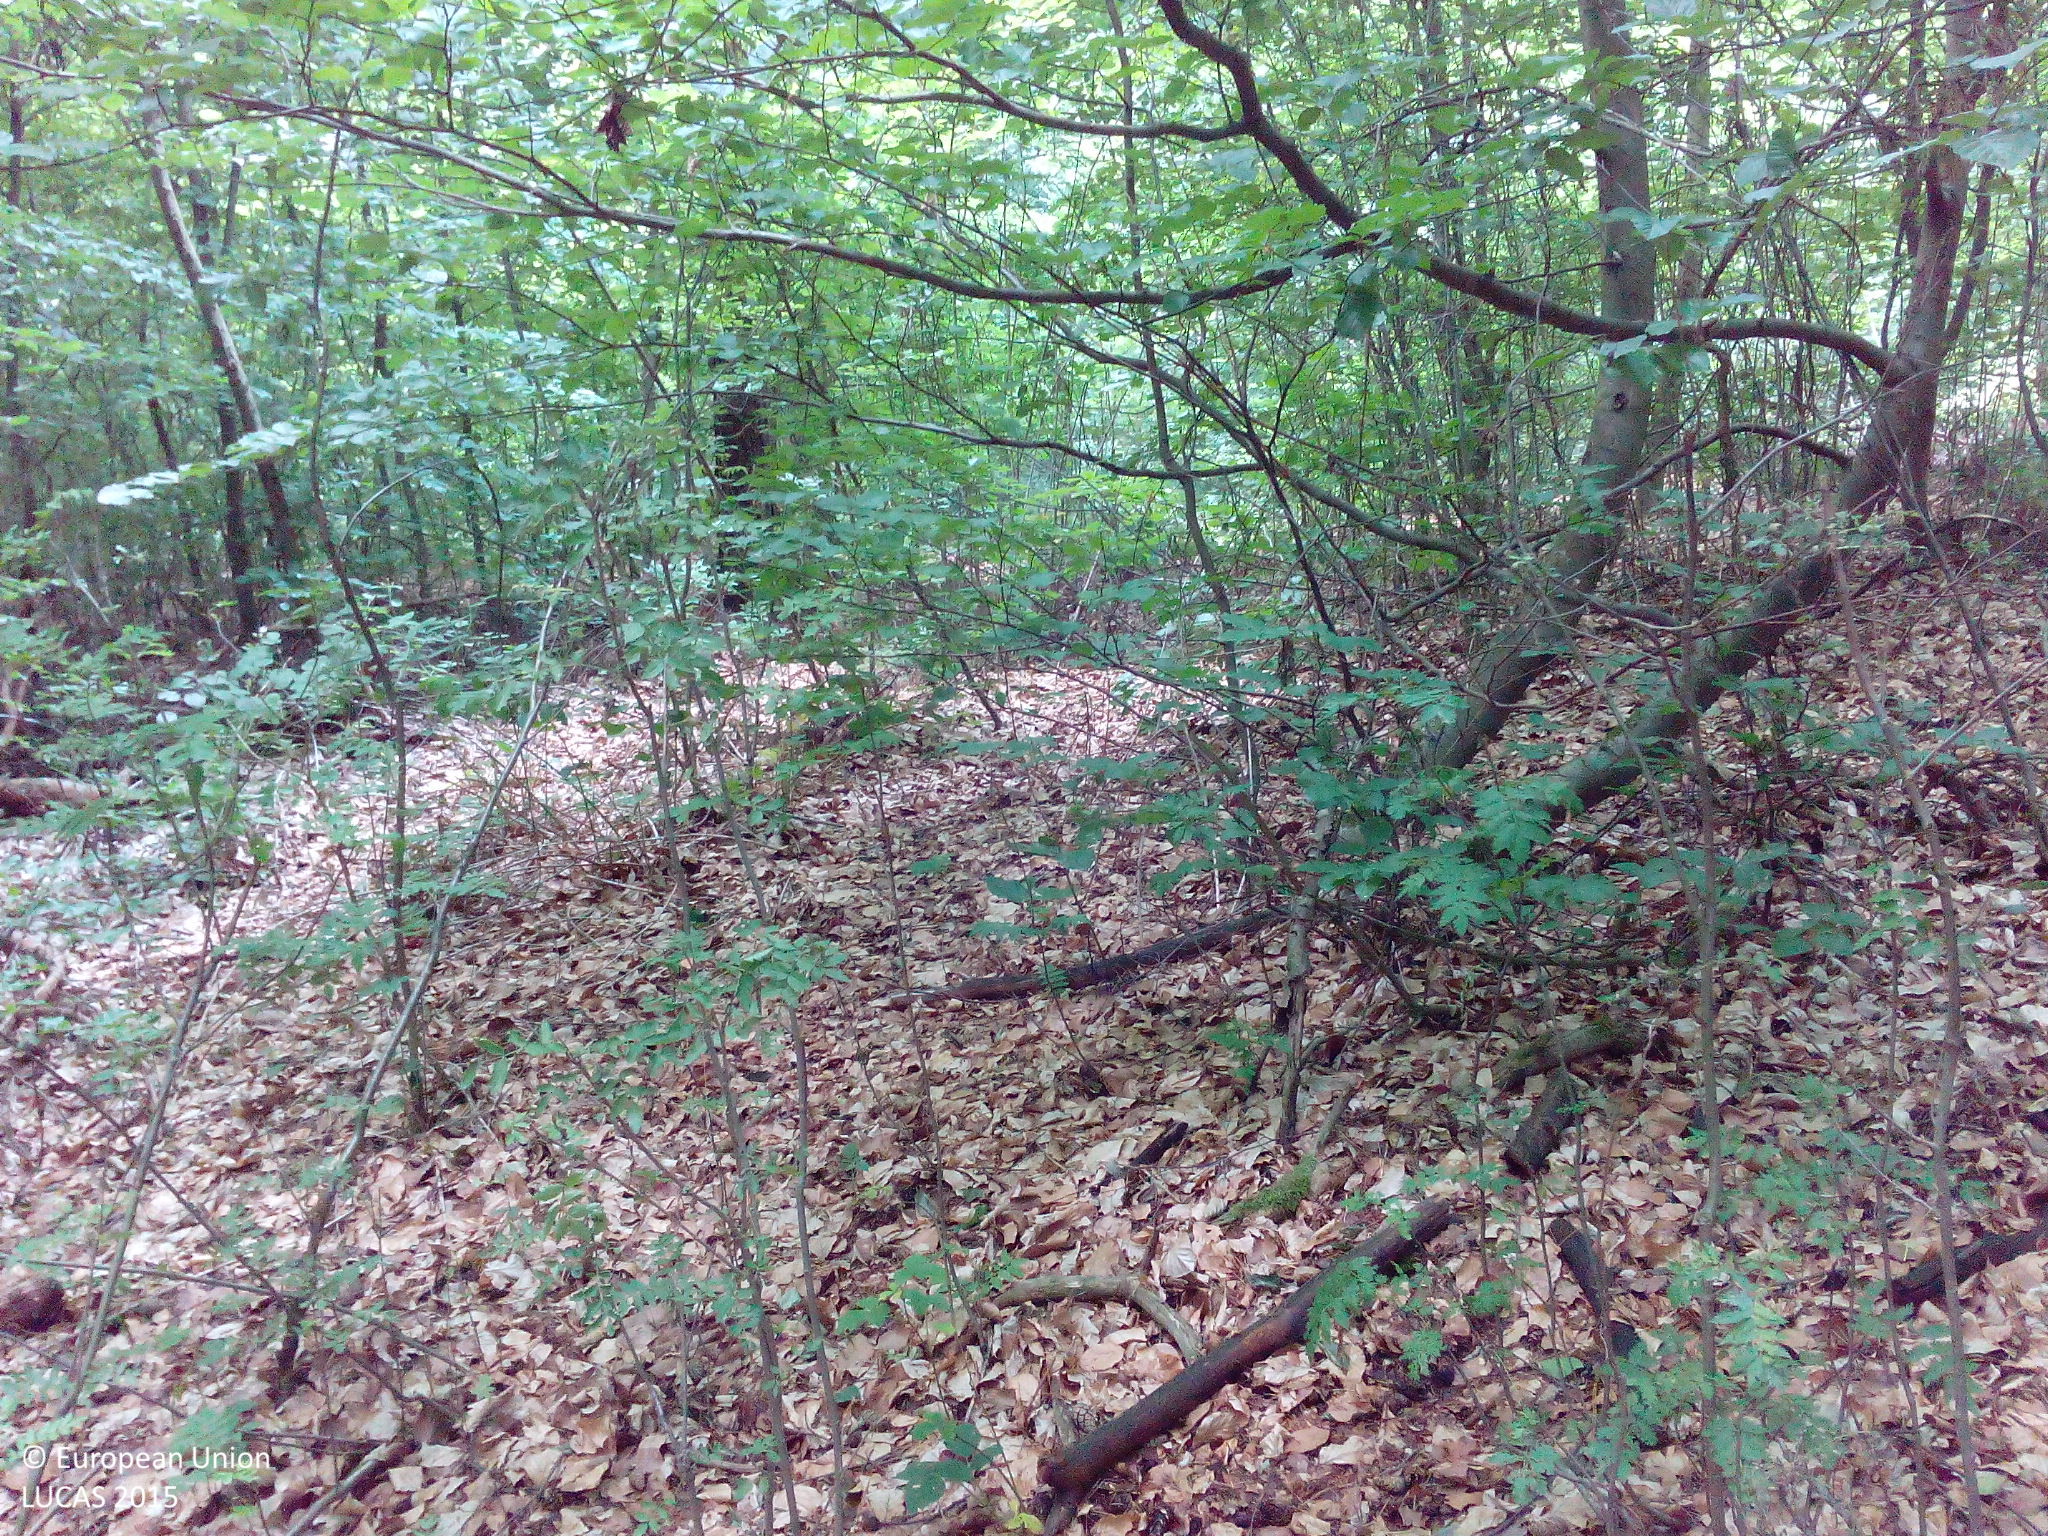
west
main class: Woodland
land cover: Pine dominated mixed woodland
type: hemiboreal forest and nemoral coniferous forest and mixed broadleaved-coniferous forest
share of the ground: > 75 %
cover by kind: coniferous forest trees 50 %, broadleaved forest trees 45 %, shrubs 5 %
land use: Forestry
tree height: > 5 m
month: July
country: DE
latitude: 52.7547
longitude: 13.6007
